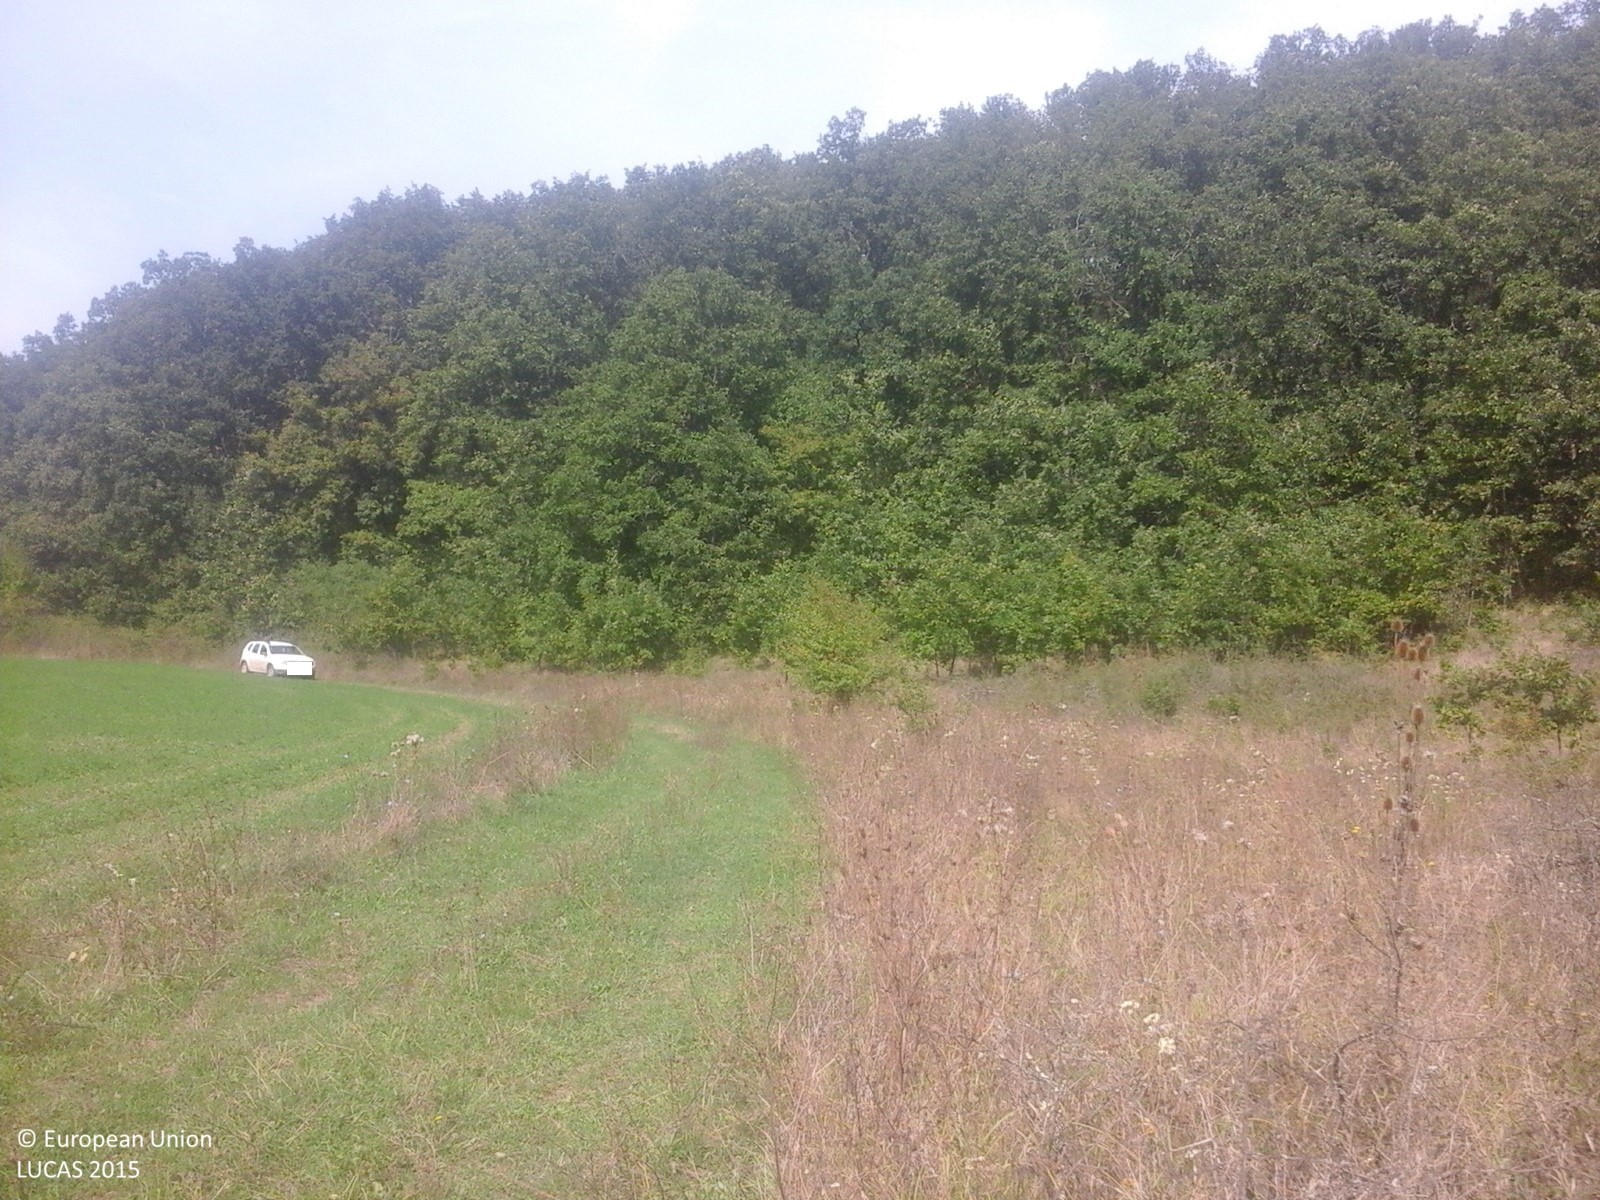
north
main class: Grassland
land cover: Spontaneously vegetated surfaces
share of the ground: > 75 %
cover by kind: herbaceous plants 100 %
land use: Semi-natural and natural areas not in use
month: September
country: RO
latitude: 46.9316
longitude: 23.2130
